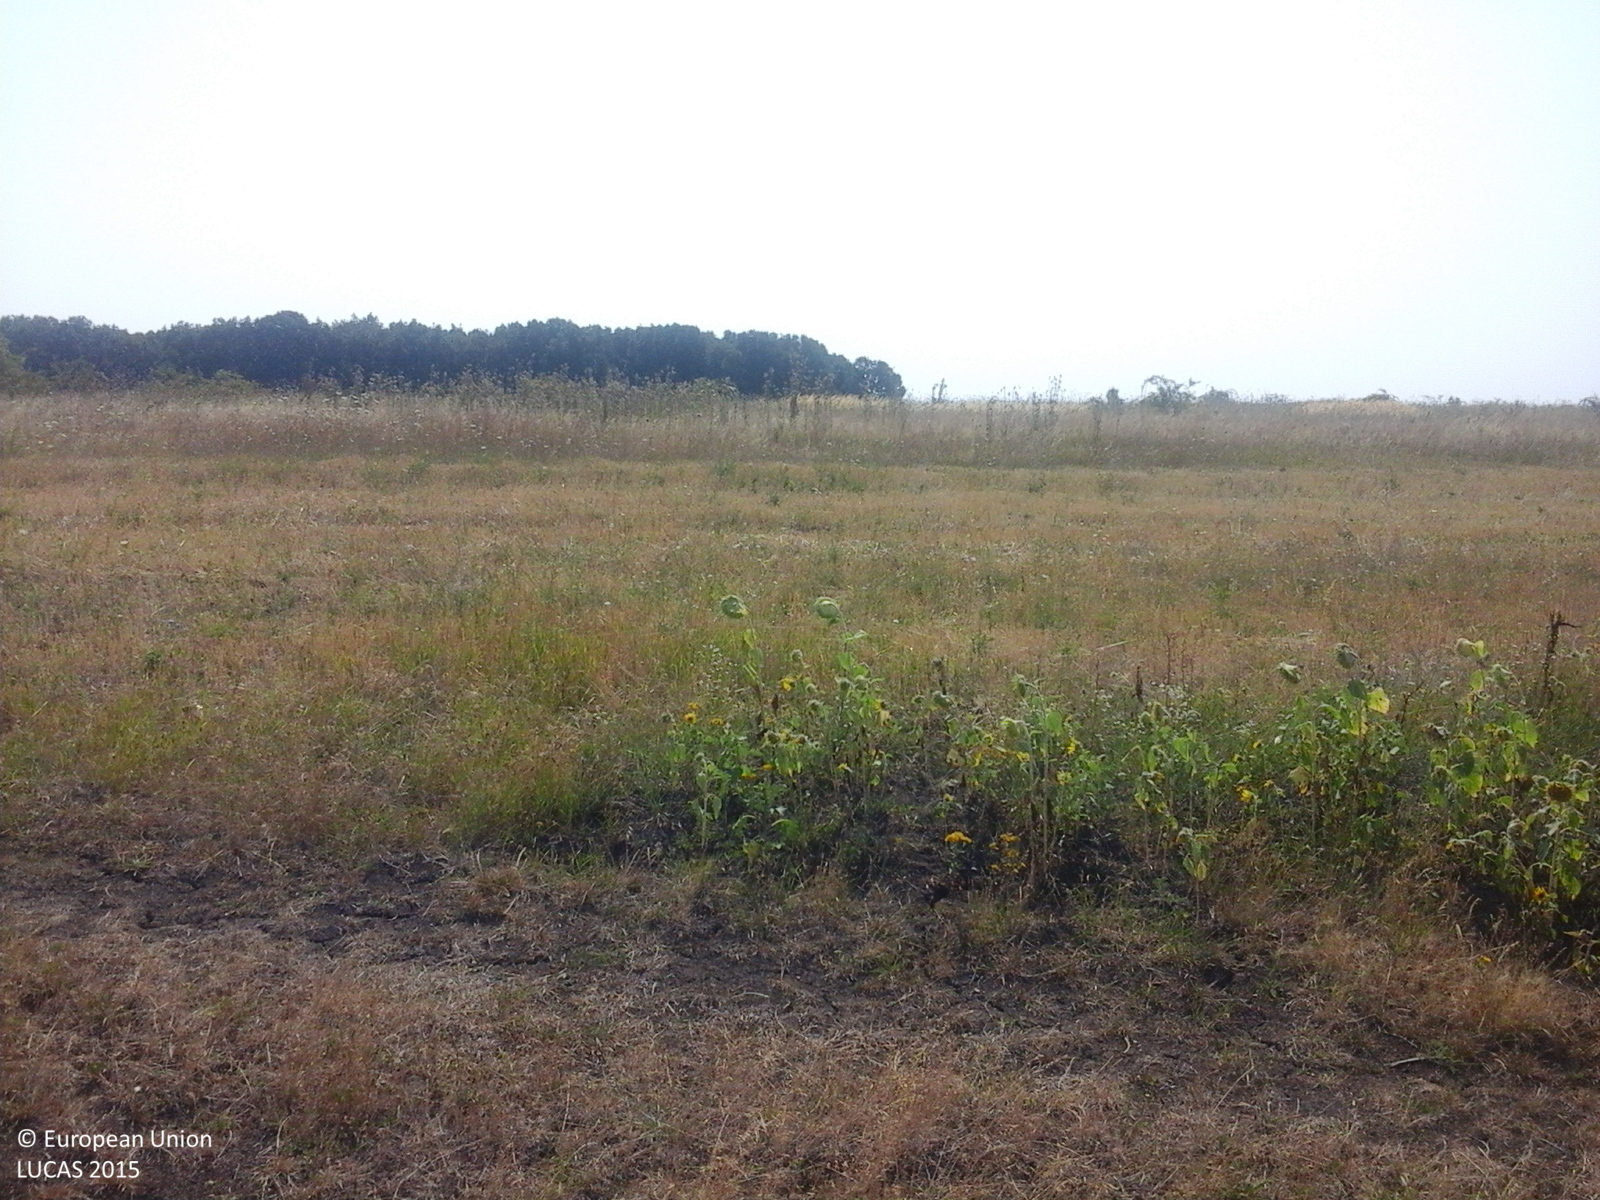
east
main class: Cropland
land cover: Sunflower
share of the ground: > 75 %
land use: Agriculture (excluding fallow land and kitchen gardens)
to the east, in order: Sunflower; Tracks; Common wheat; Spontaneously vegetated surfaces; Common wheat; Spontaneously vegetated surfaces; Lines of trees; Fences; Maize; Fences; Other fruit trees and berries; Fences; Grassland without tree/shrub cover
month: August
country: RO
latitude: 44.5060
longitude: 23.0650
